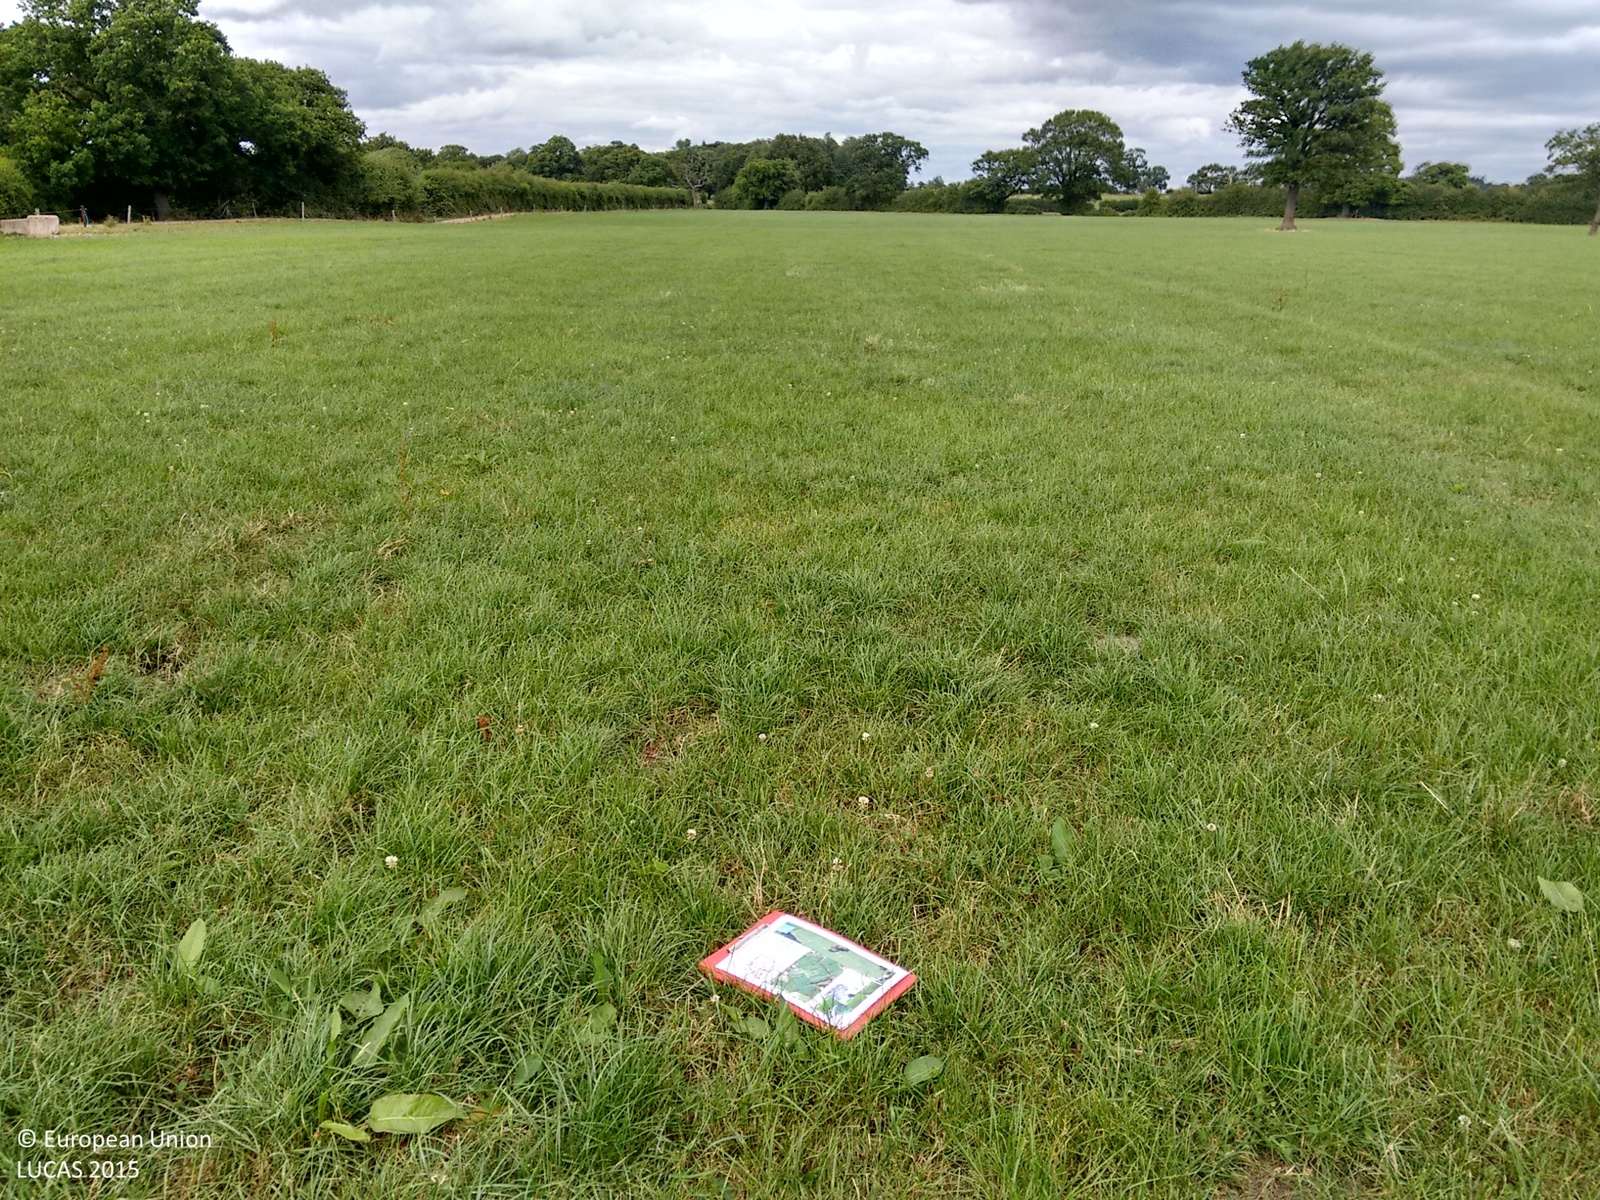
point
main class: Grassland
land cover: Grassland without tree/shrub cover
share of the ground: > 75 %
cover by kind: herbaceous plants 100 %
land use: Agriculture (excluding fallow land and kitchen gardens)
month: July
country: GB
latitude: 53.0619
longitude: -2.8299
